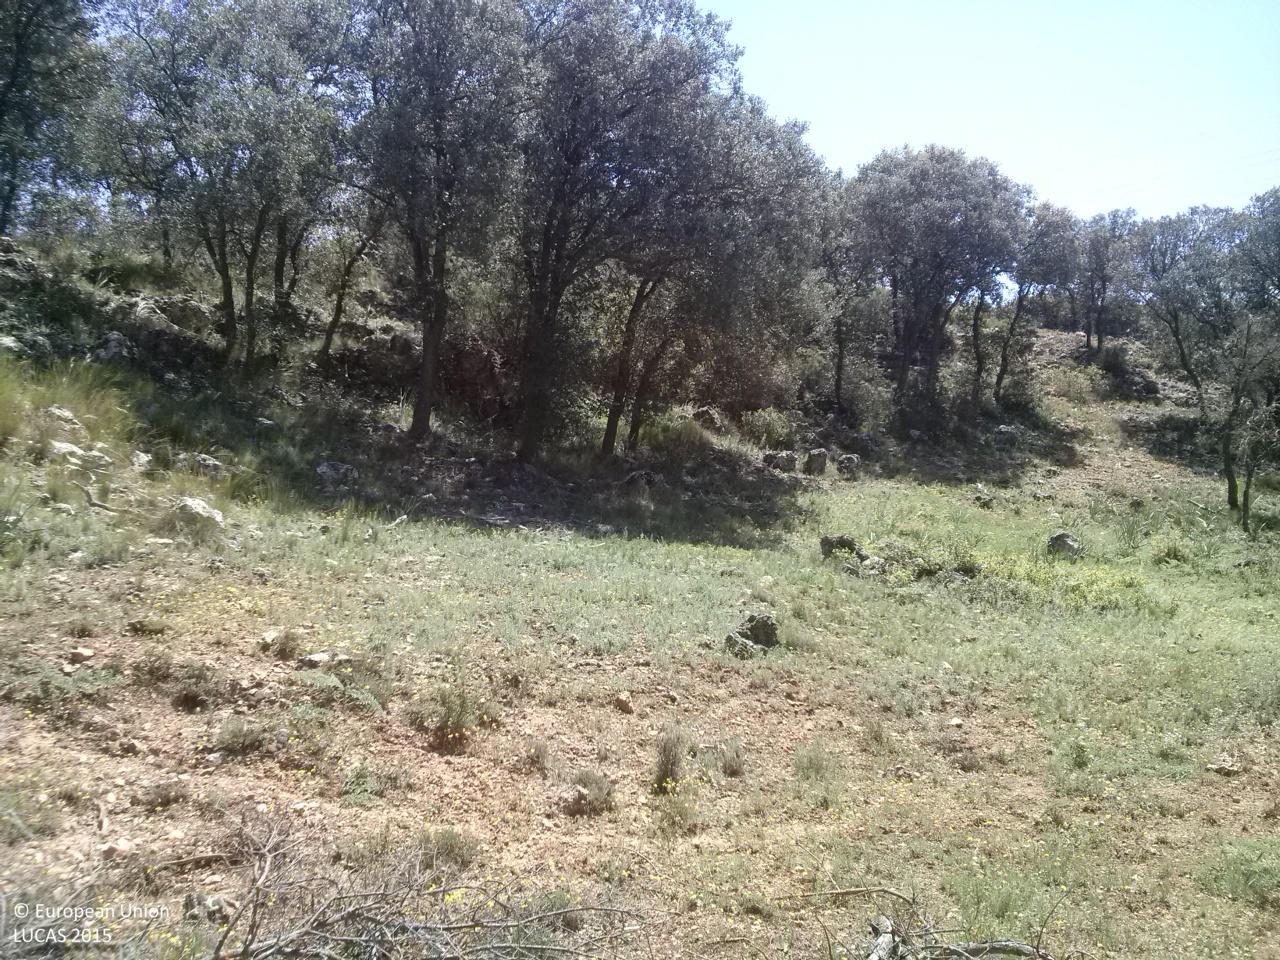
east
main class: Shrubland
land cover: Shrubland with sparse tree cover
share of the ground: 25 - 50 %
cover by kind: shrubs 45 %, herbaceous plants 25 %, unconsolidated bare surface 25 %, broadleaved forest trees 5 %
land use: Agriculture (excluding fallow land and kitchen gardens)
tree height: > 5 m
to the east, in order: Shrubland with sparse tree cover; Arable land (only in case pi); Grass margins; Single bushes/trees; Grass margins; Arable land (only in case pi)
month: May
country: ES
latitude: 39.7637
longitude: -2.7298
